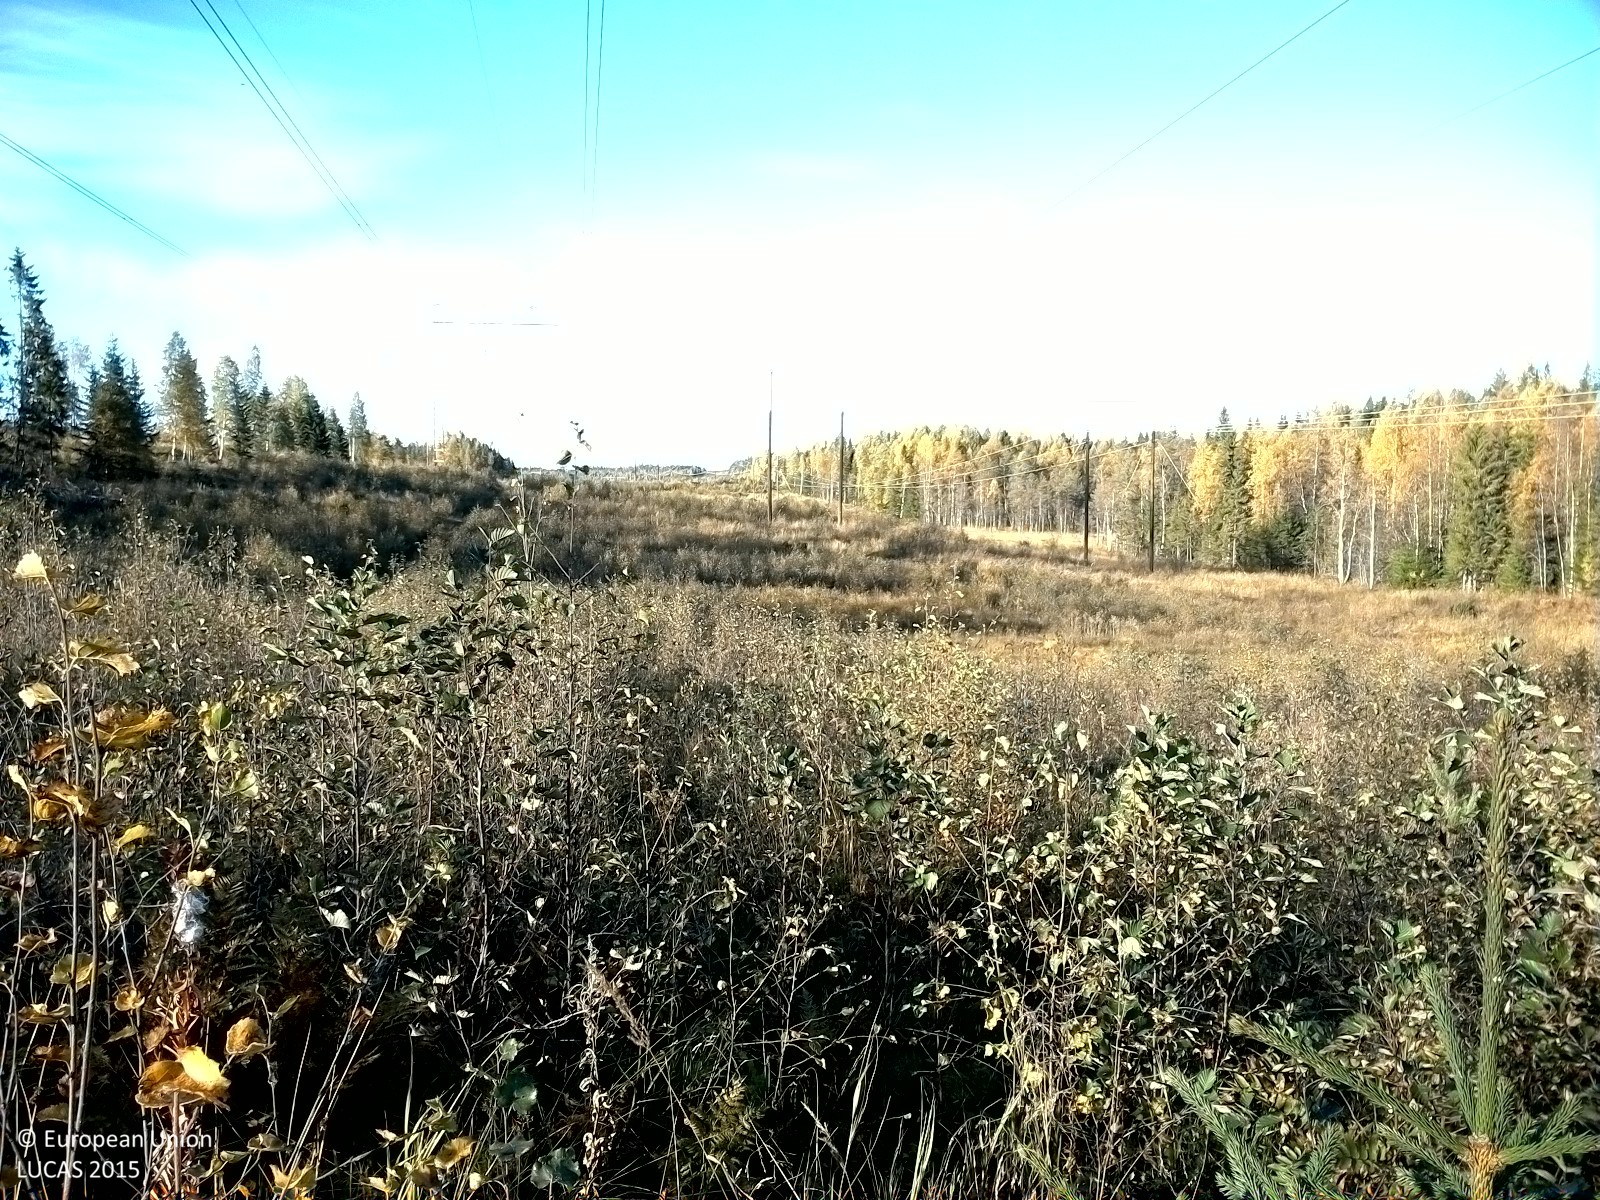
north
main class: Artificial land
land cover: Other artificial areas
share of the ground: > 75 %
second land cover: Broadleaved woodland
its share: > 75 %
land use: Electricity, gas and thermal power distribution
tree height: < 5 m
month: September
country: SE
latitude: 62.3987
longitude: 16.9255
